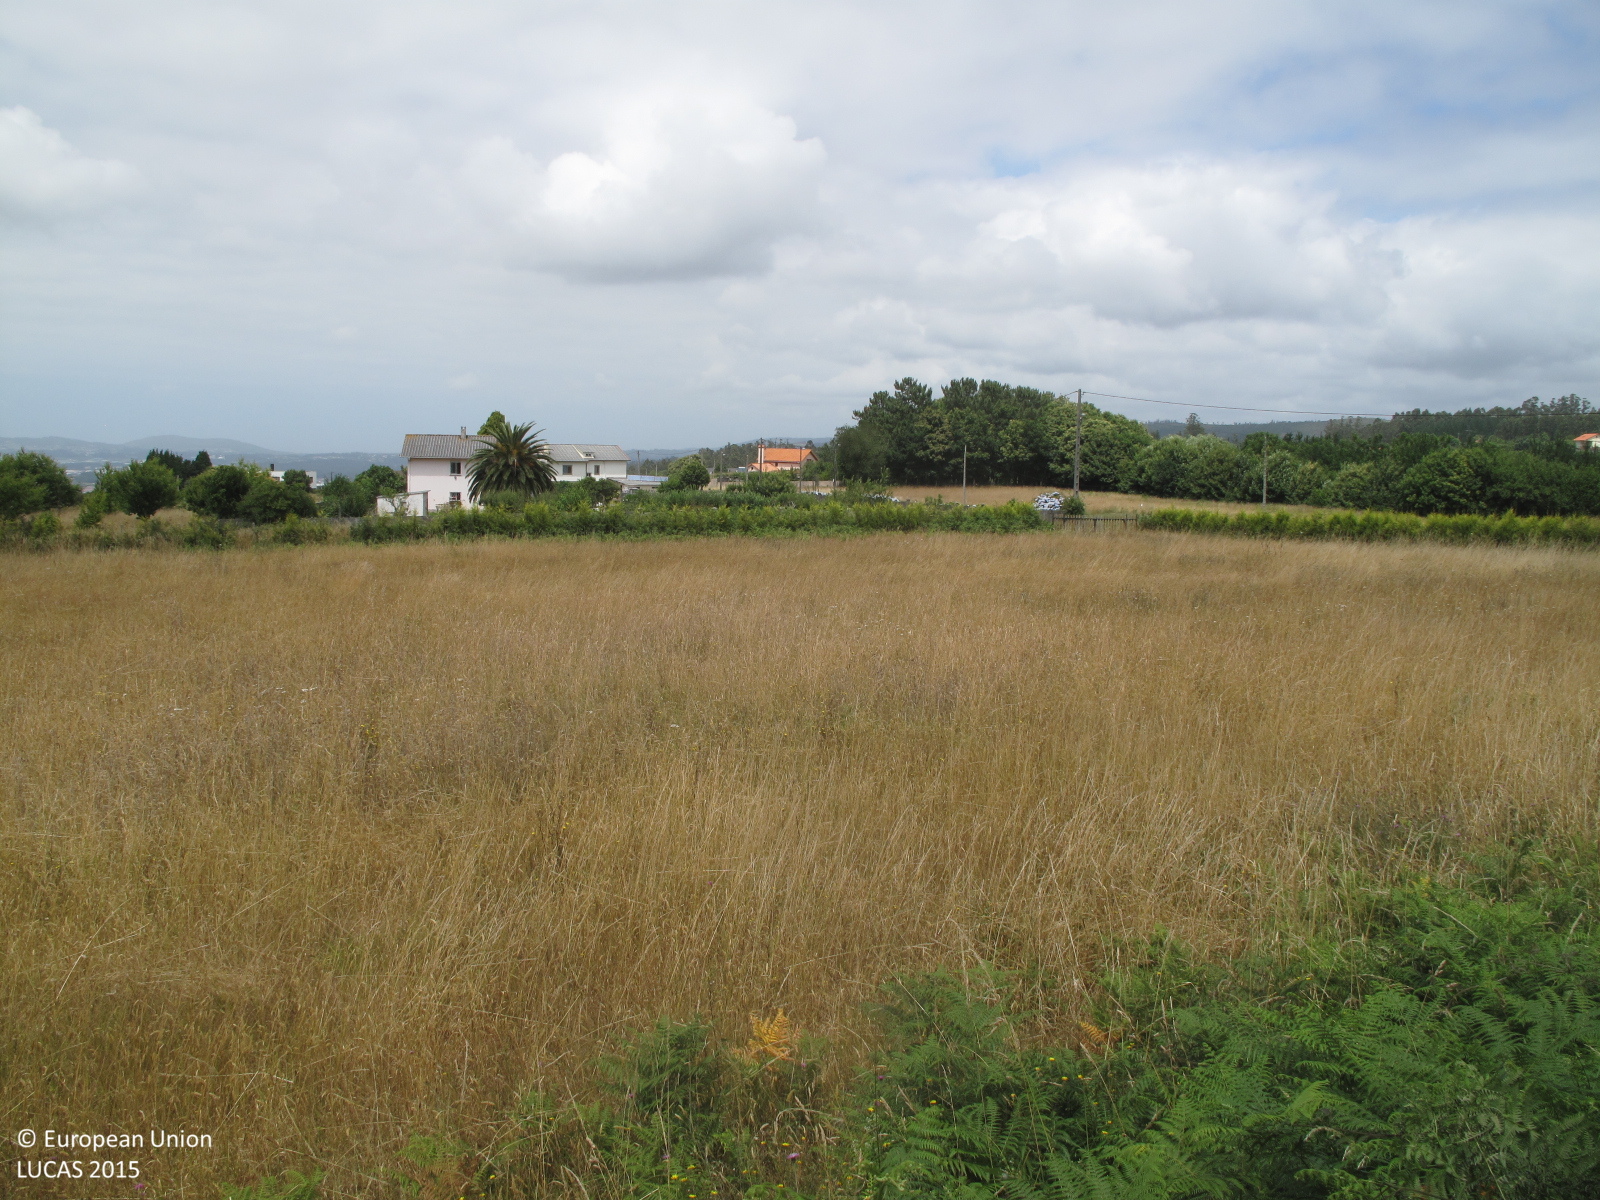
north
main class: Grassland
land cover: Grassland with sparse tree/shrub cover
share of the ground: > 75 %
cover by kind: herbaceous plants 90 %, broadleaved forest trees 5 %, unconsolidated bare surface 5 %
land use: Forestry
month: July
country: ES
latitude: 43.4522
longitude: -8.1548
